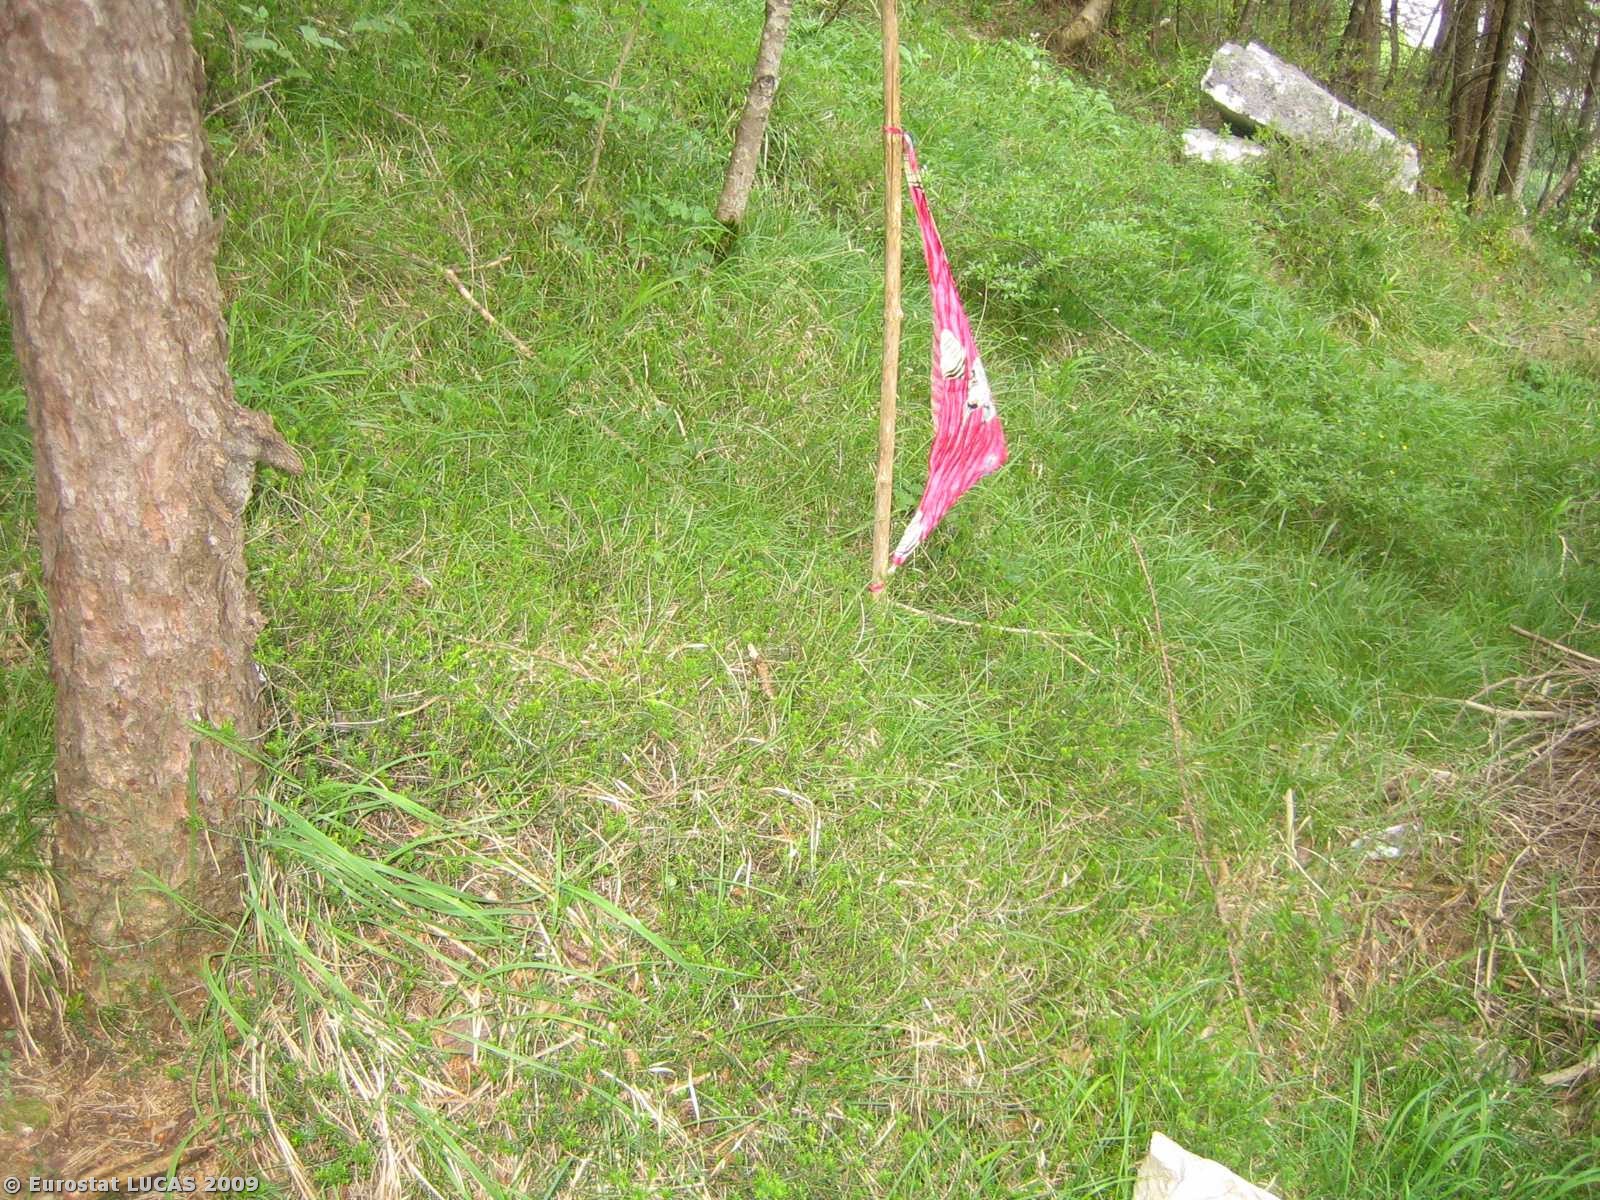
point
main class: Woodland
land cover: Mixed woodland
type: hemiboreal forest and nemoral coniferous forest and mixed broadleaved-coniferous forest
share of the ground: 50 - 75 %
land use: Forestry
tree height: > 5 m
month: May
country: IT
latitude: 46.1384
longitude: 11.7711
